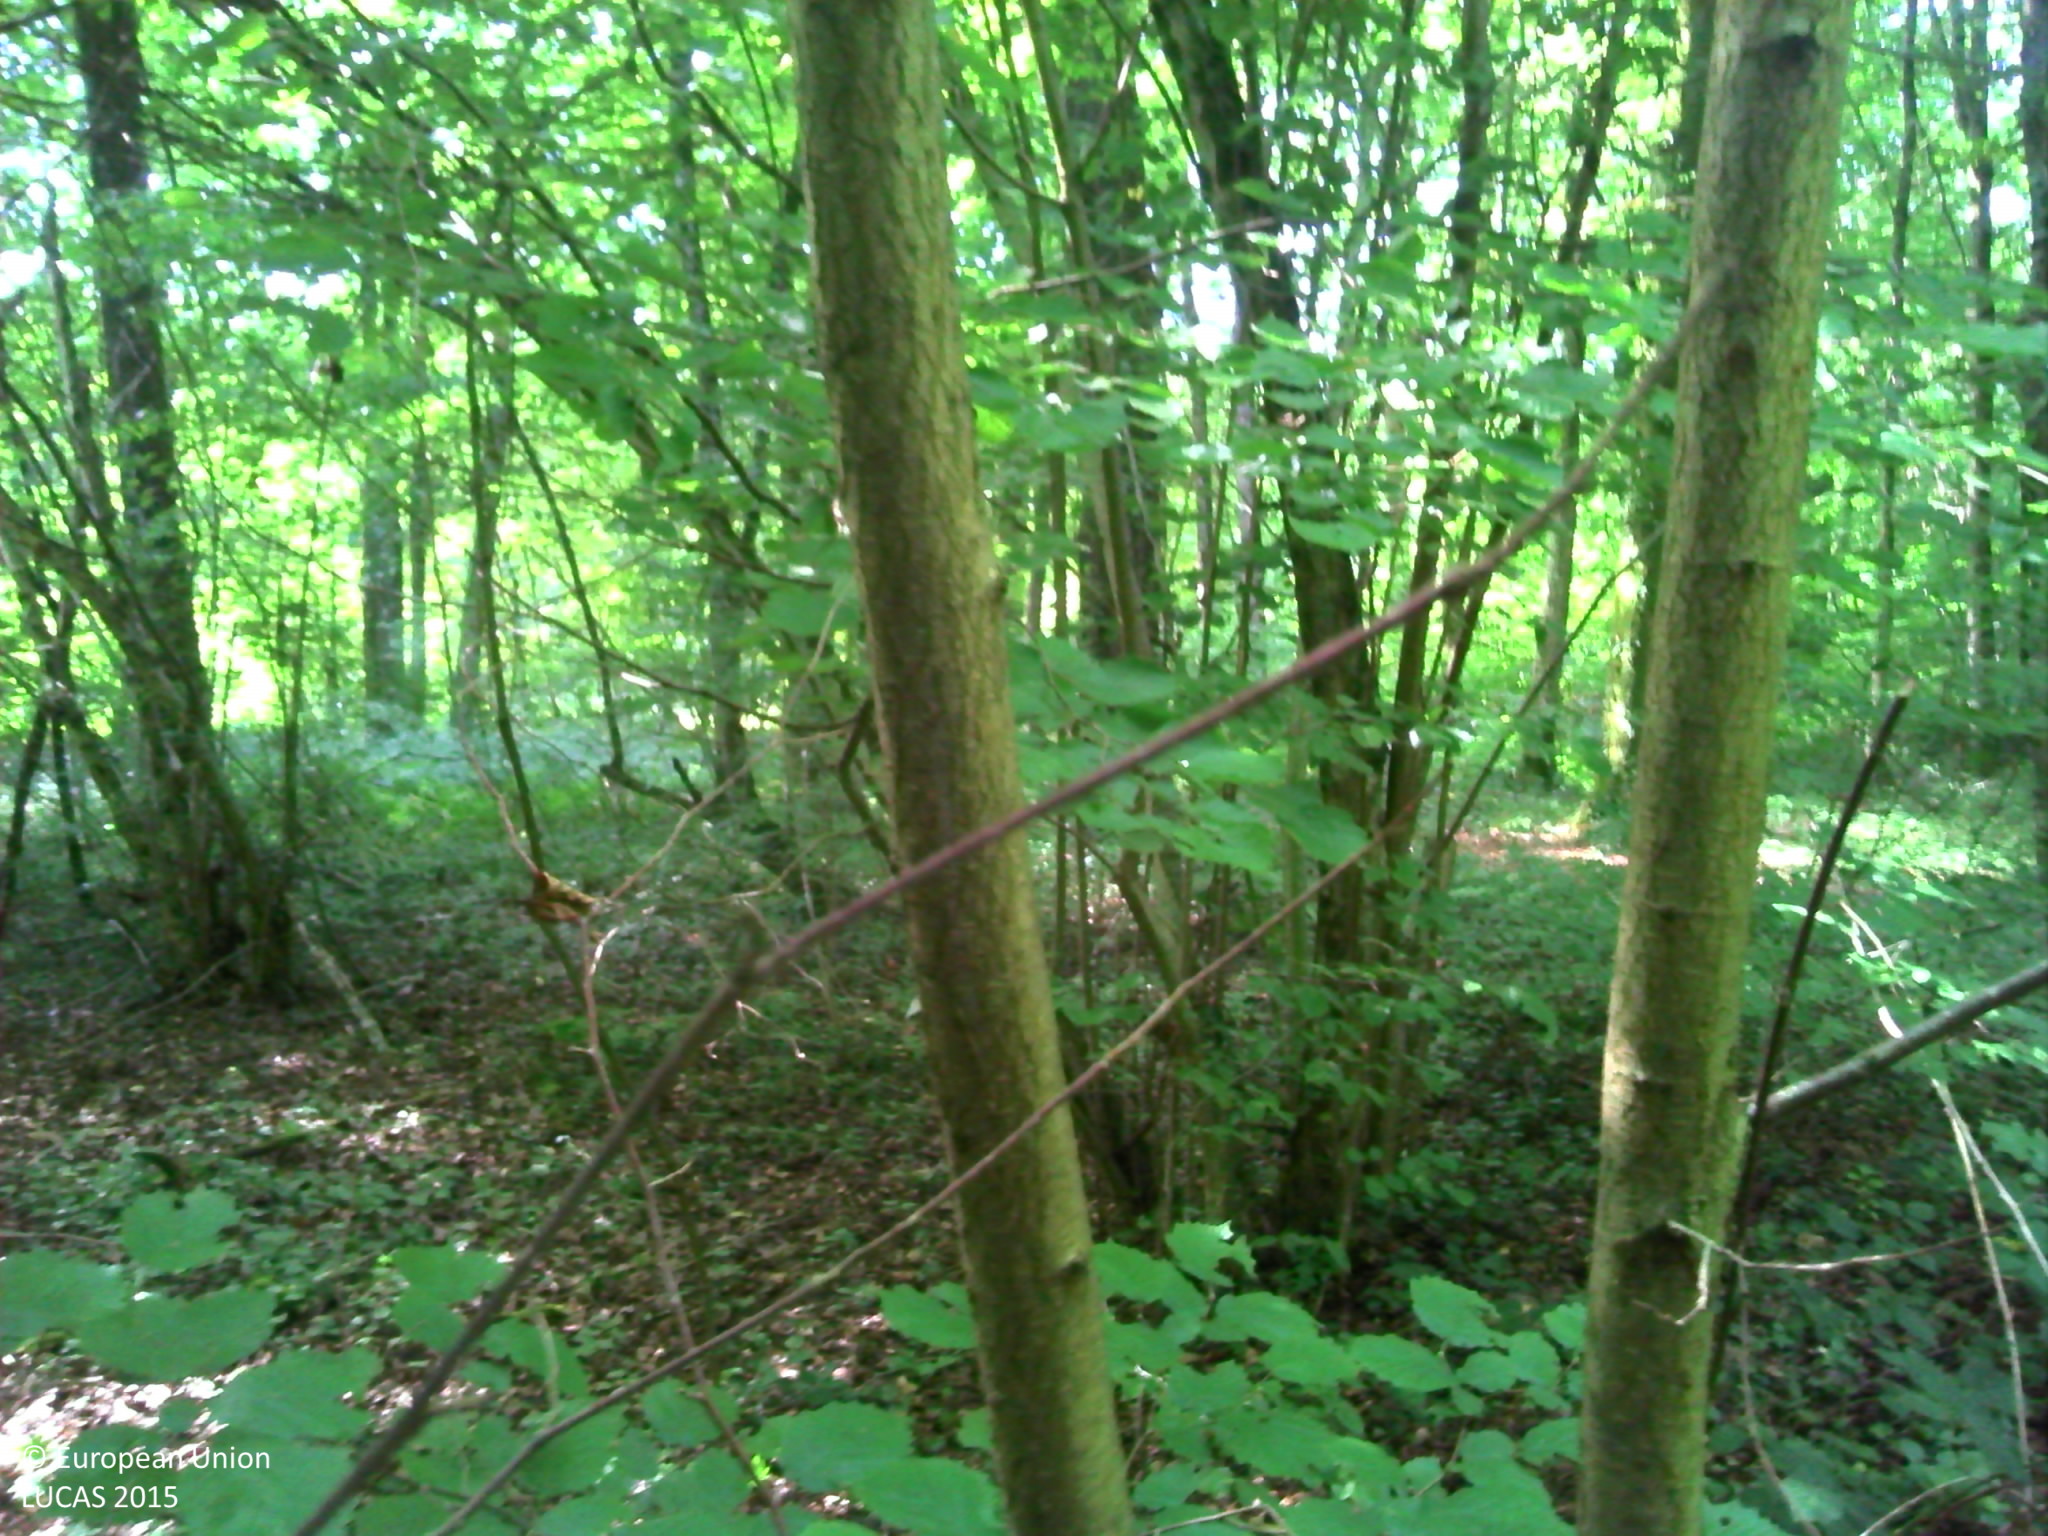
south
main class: Woodland
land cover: Broadleaved woodland
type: mesophytic deciduous forest
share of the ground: > 75 %
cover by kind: broadleaved forest trees 95 %, herbaceous plants 5 %
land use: Forestry
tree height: > 5 m
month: August
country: FR
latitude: 49.5452
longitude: 5.2575
